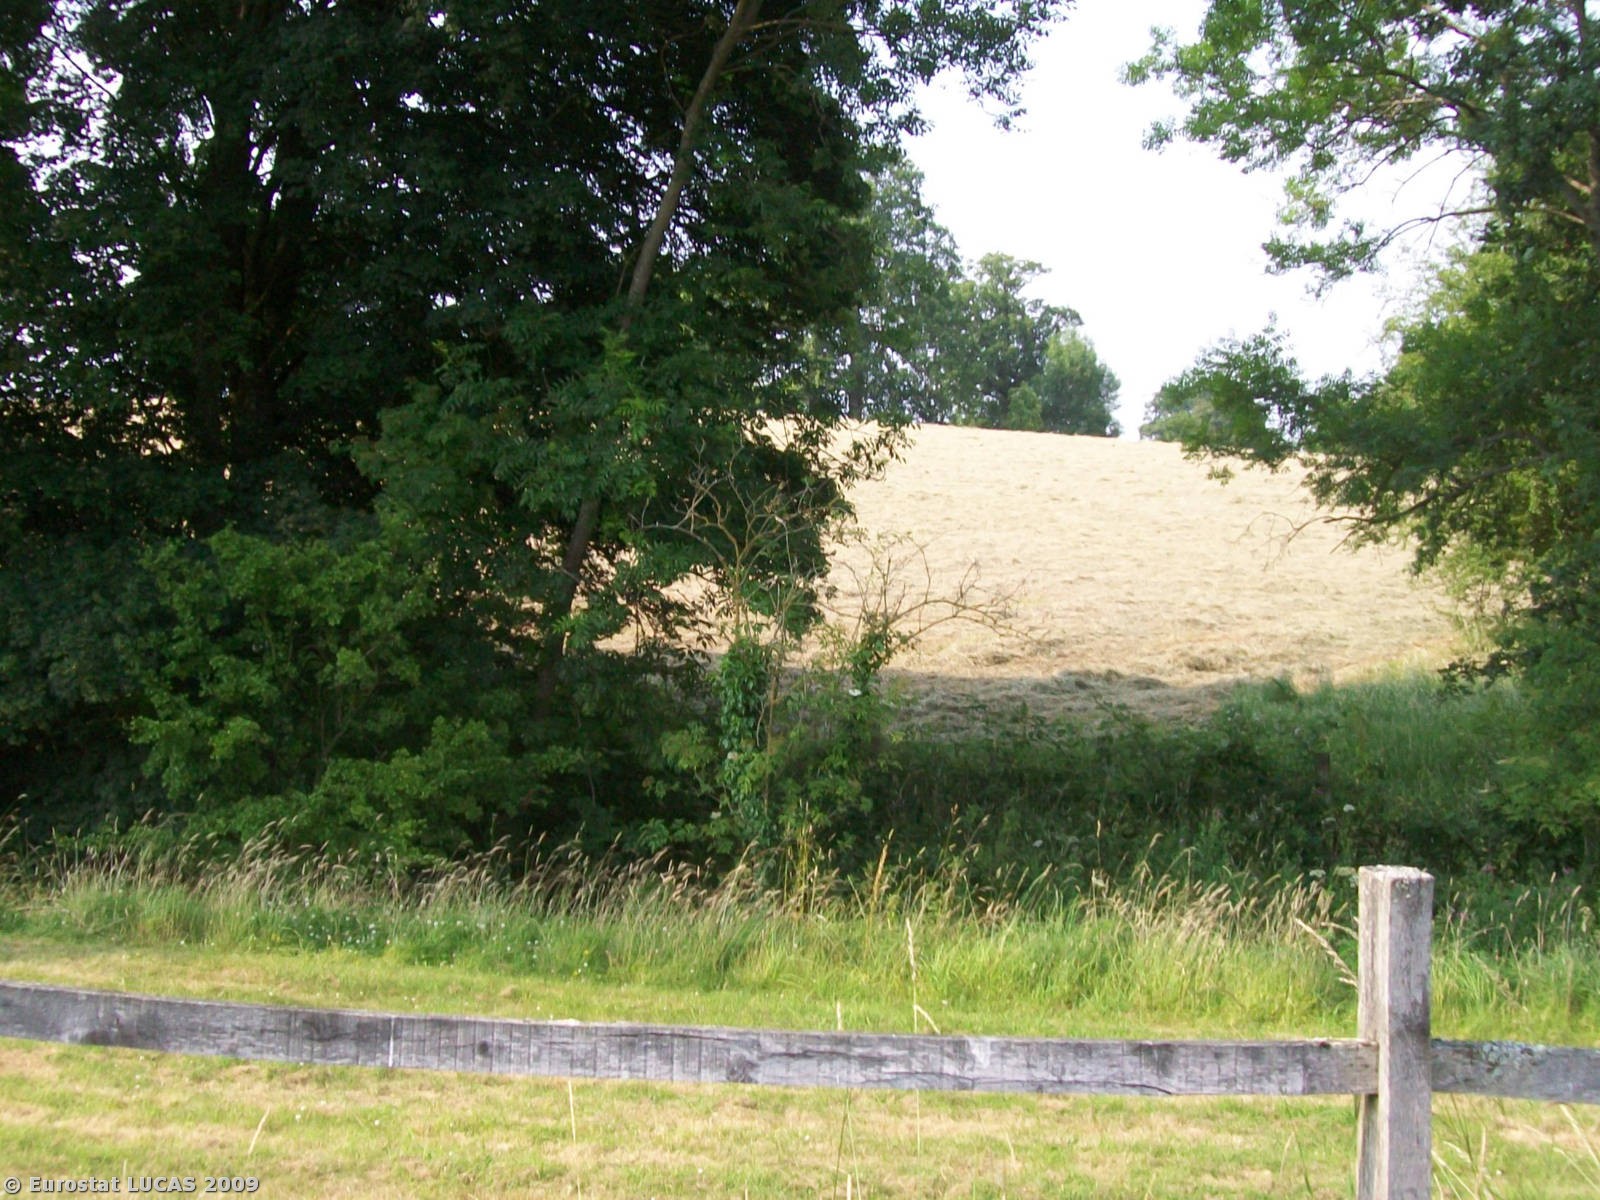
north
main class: Grassland
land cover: Grassland without tree/shrub cover
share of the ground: > 75 %
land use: Agriculture (excluding fallow land and kitchen gardens)
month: July
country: GB
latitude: 51.1166
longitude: -0.6544
